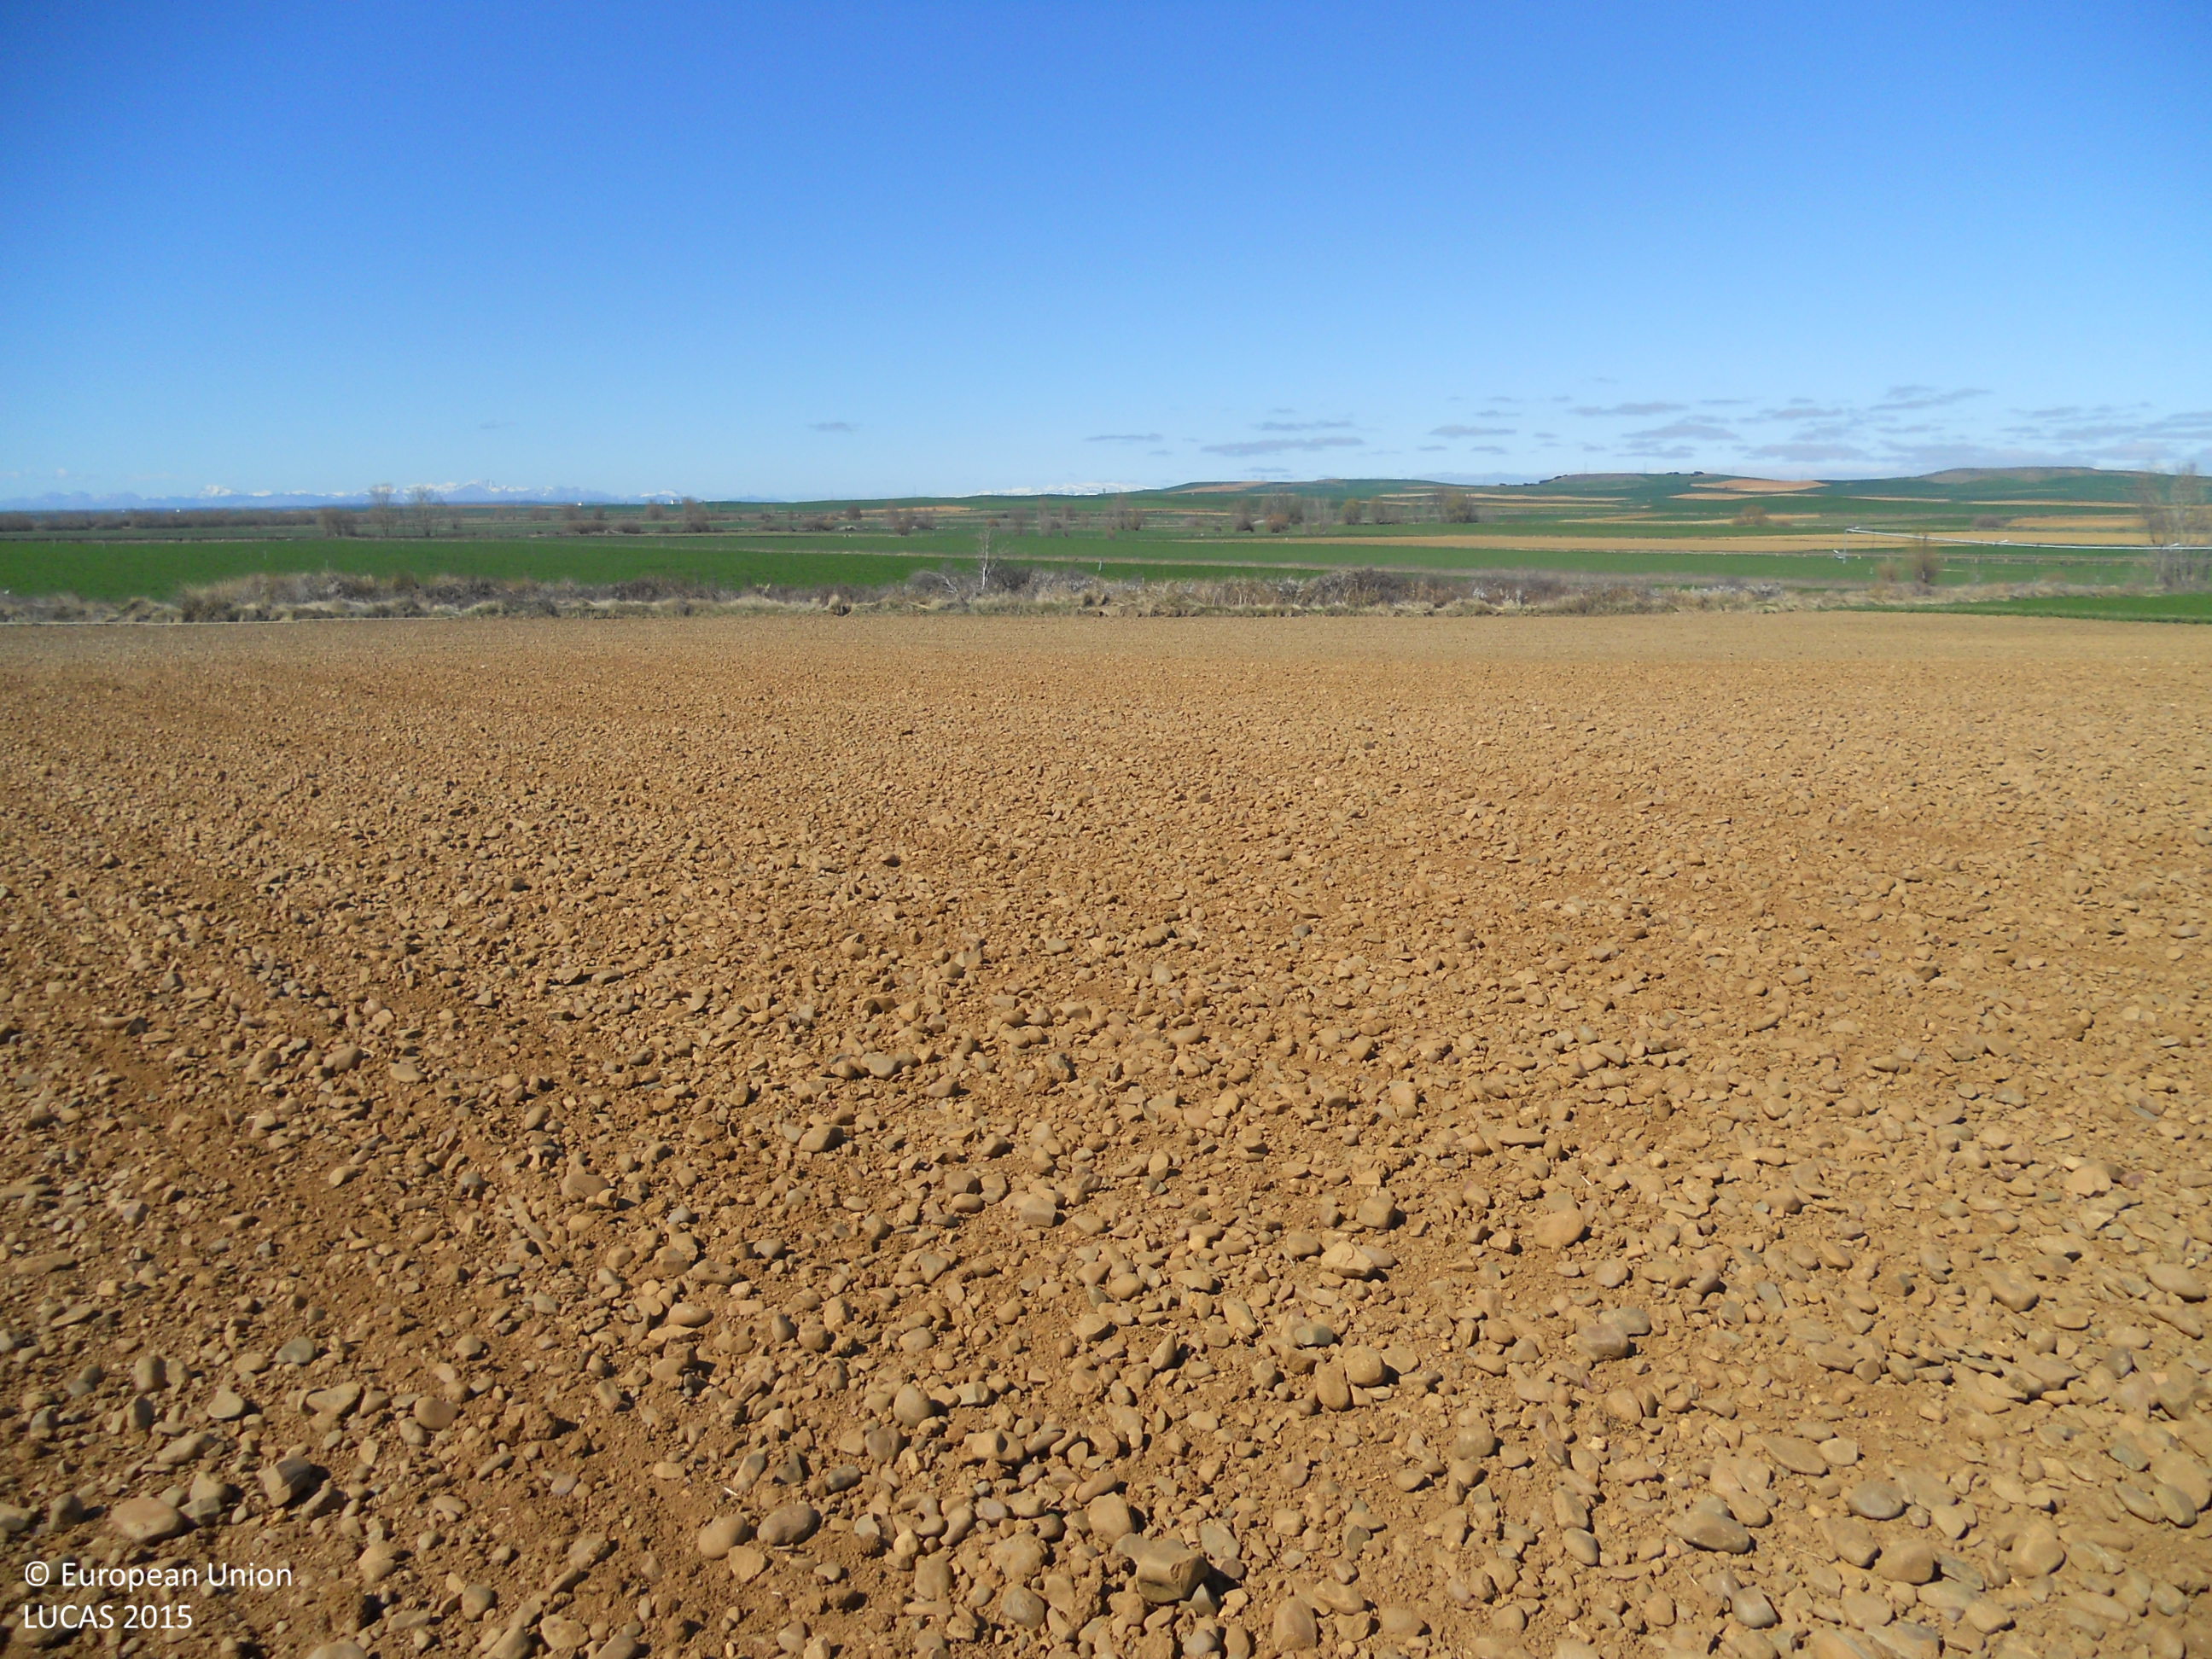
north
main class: Cropland
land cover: Lucerne
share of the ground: > 75 %
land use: Agriculture (excluding fallow land and kitchen gardens)
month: April
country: ES
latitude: 42.3428
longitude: -4.3330
